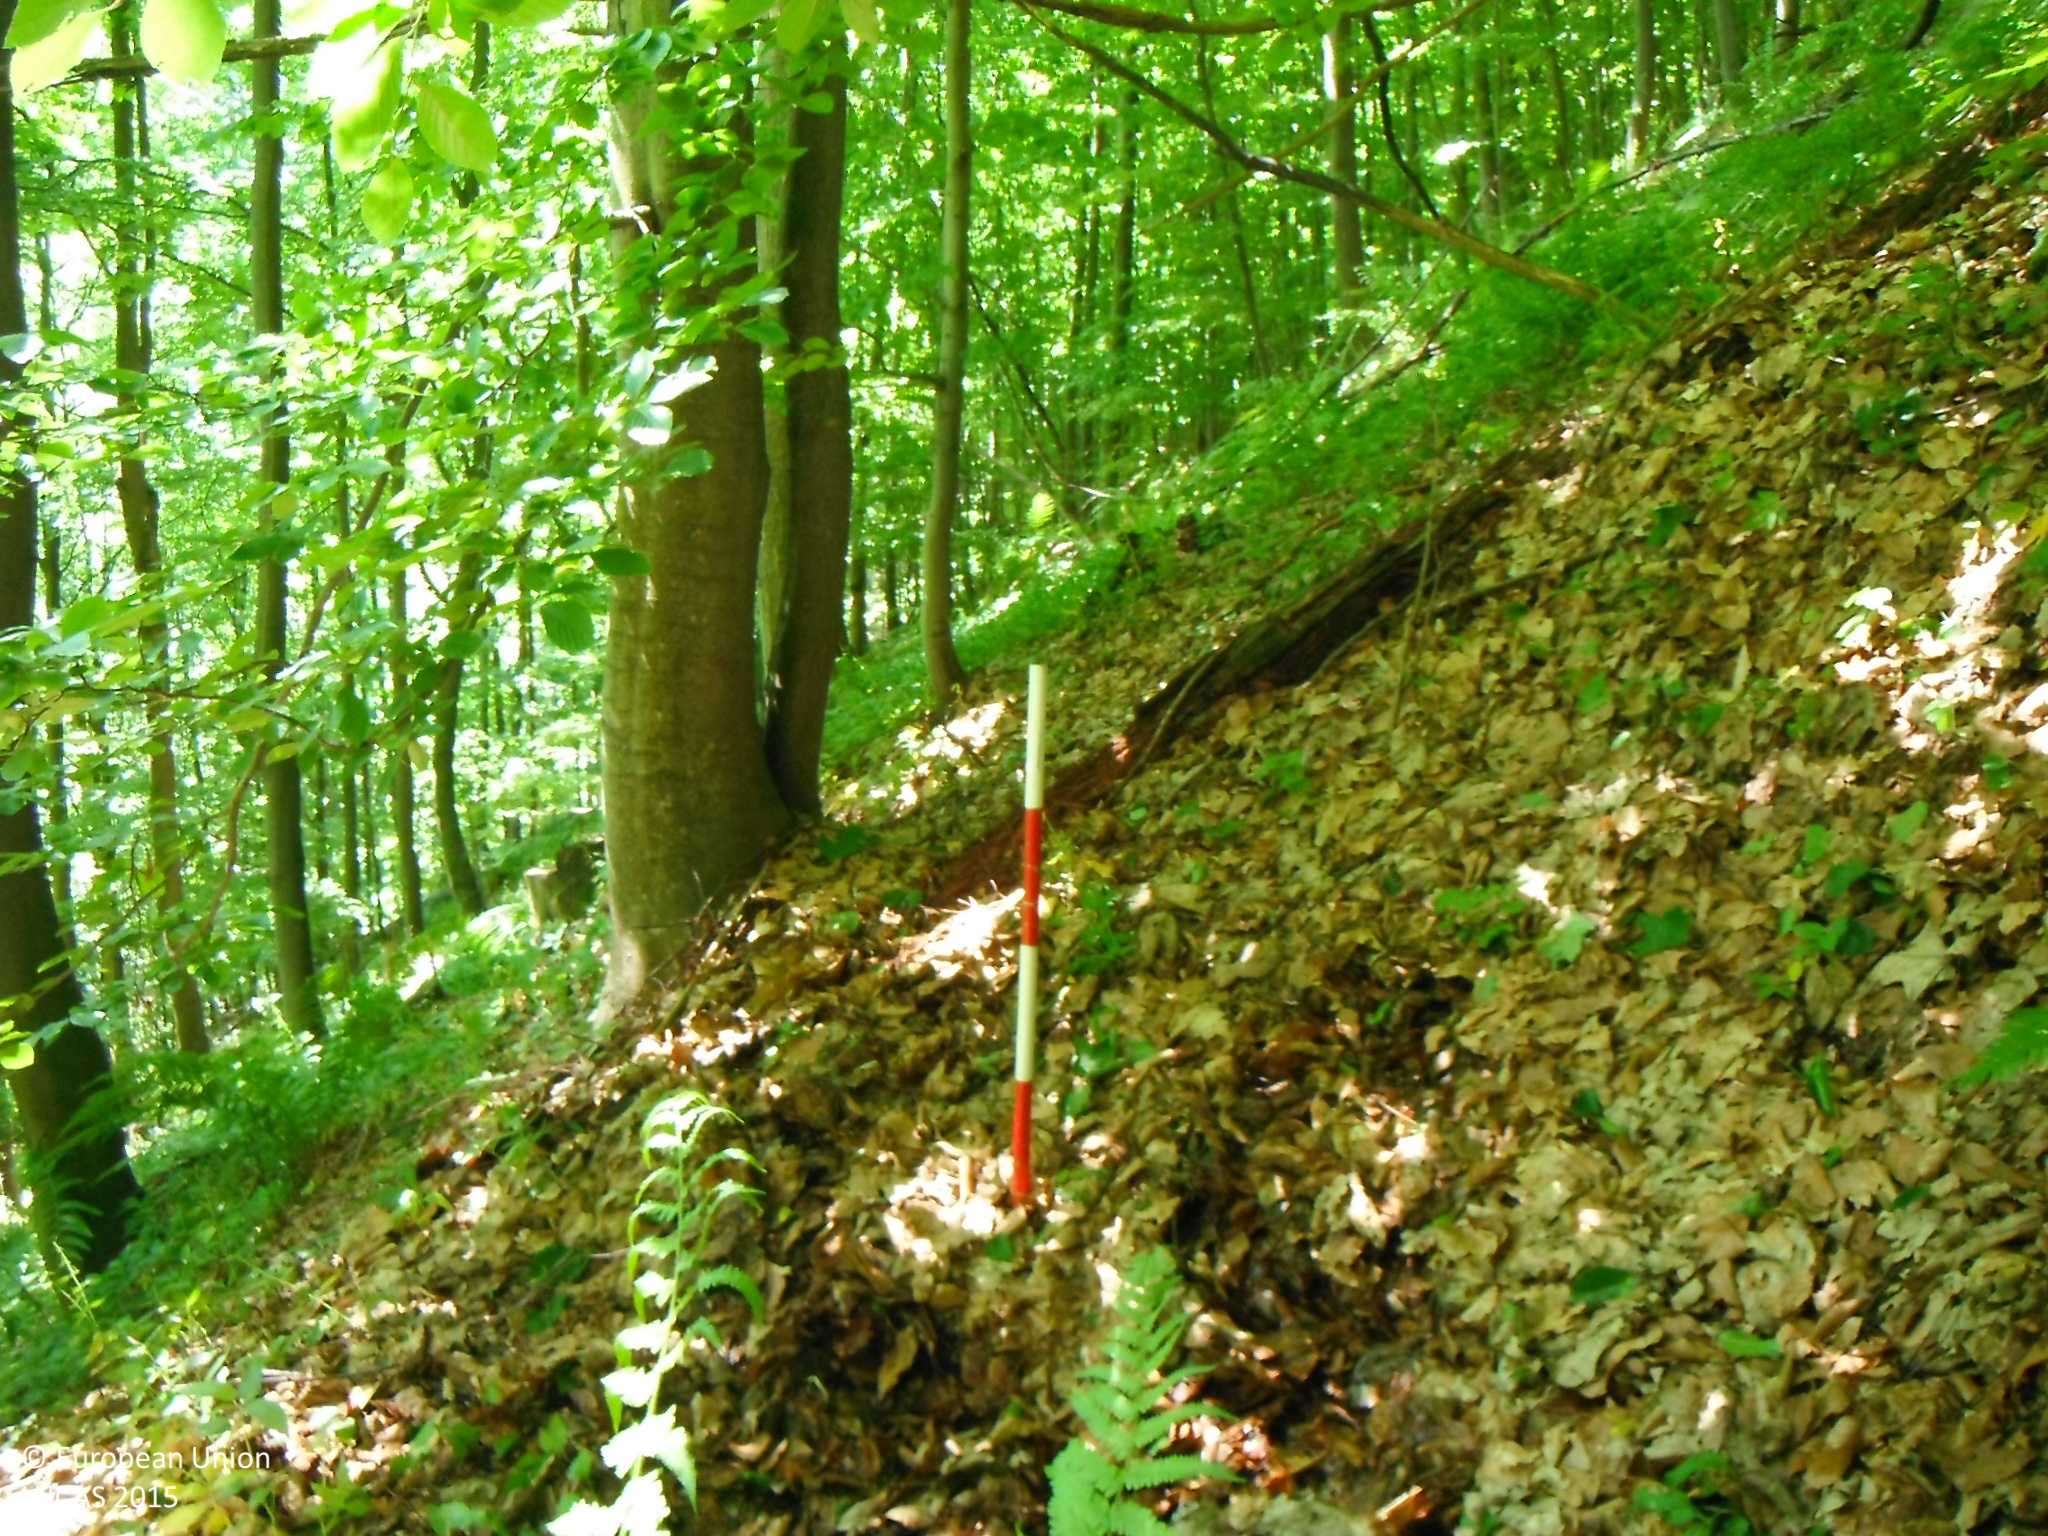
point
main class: Woodland
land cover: Broadleaved woodland
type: beech forest
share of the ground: > 75 %
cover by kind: broadleaved forest trees 95 %, herbaceous plants 5 %
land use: Forestry
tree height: > 5 m
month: May
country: SK
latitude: 48.5688
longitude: 19.5526
